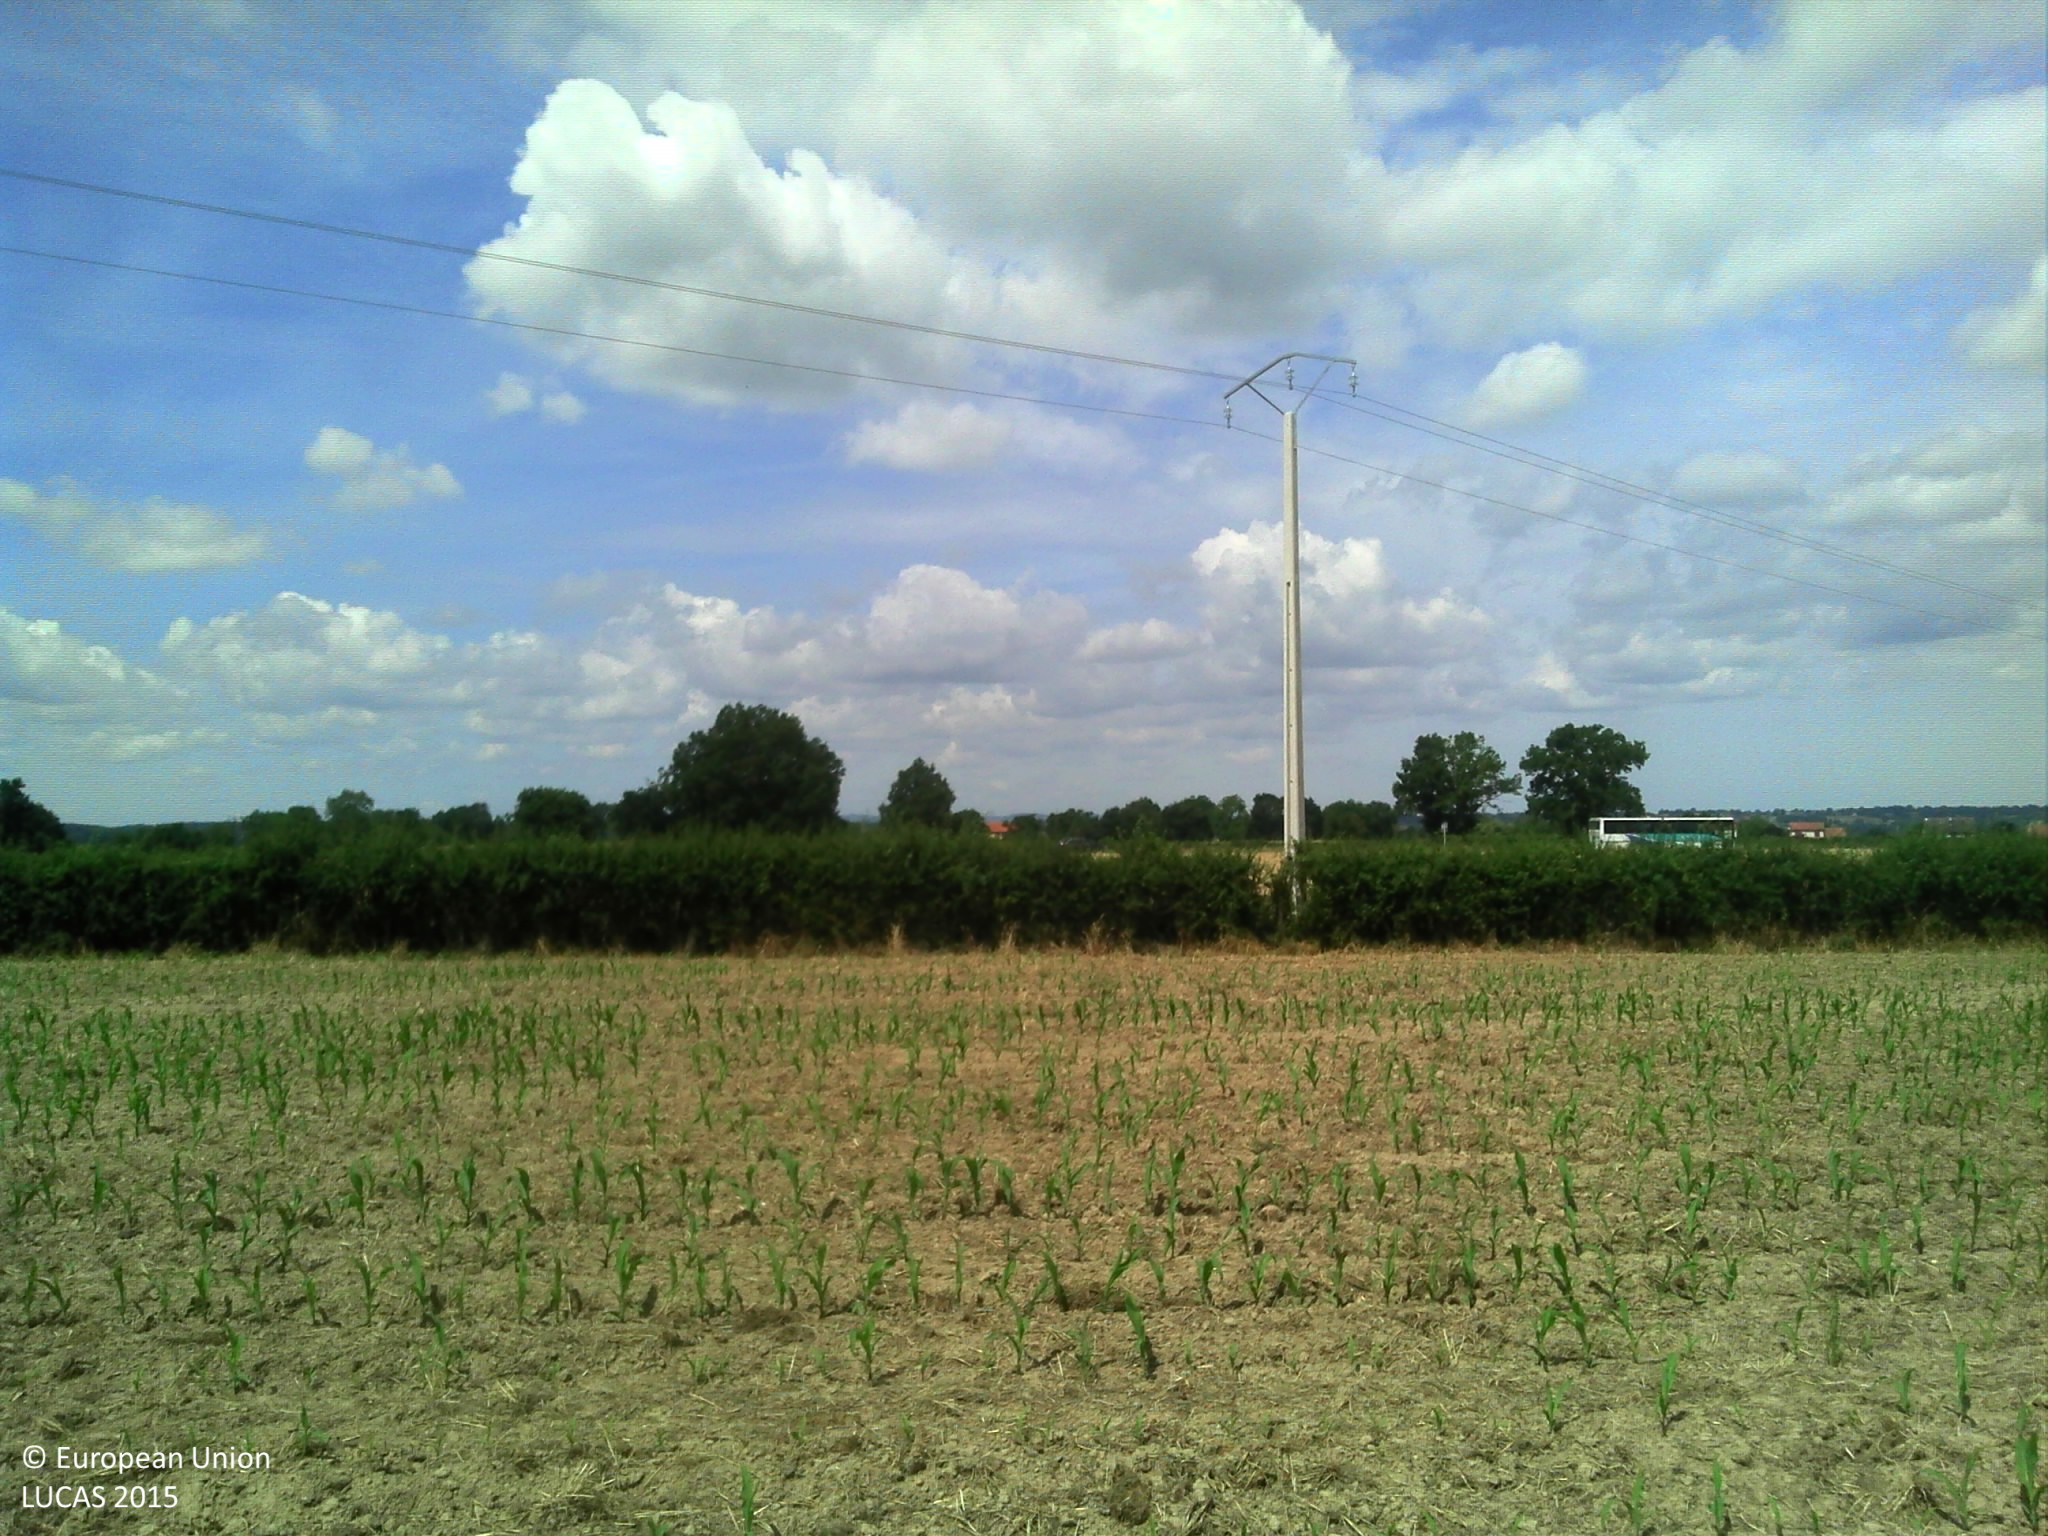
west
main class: Cropland
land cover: Maize
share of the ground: 10 - 25 %
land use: Agriculture (excluding fallow land and kitchen gardens)
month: June
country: FR
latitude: 46.2935
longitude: 4.0425
